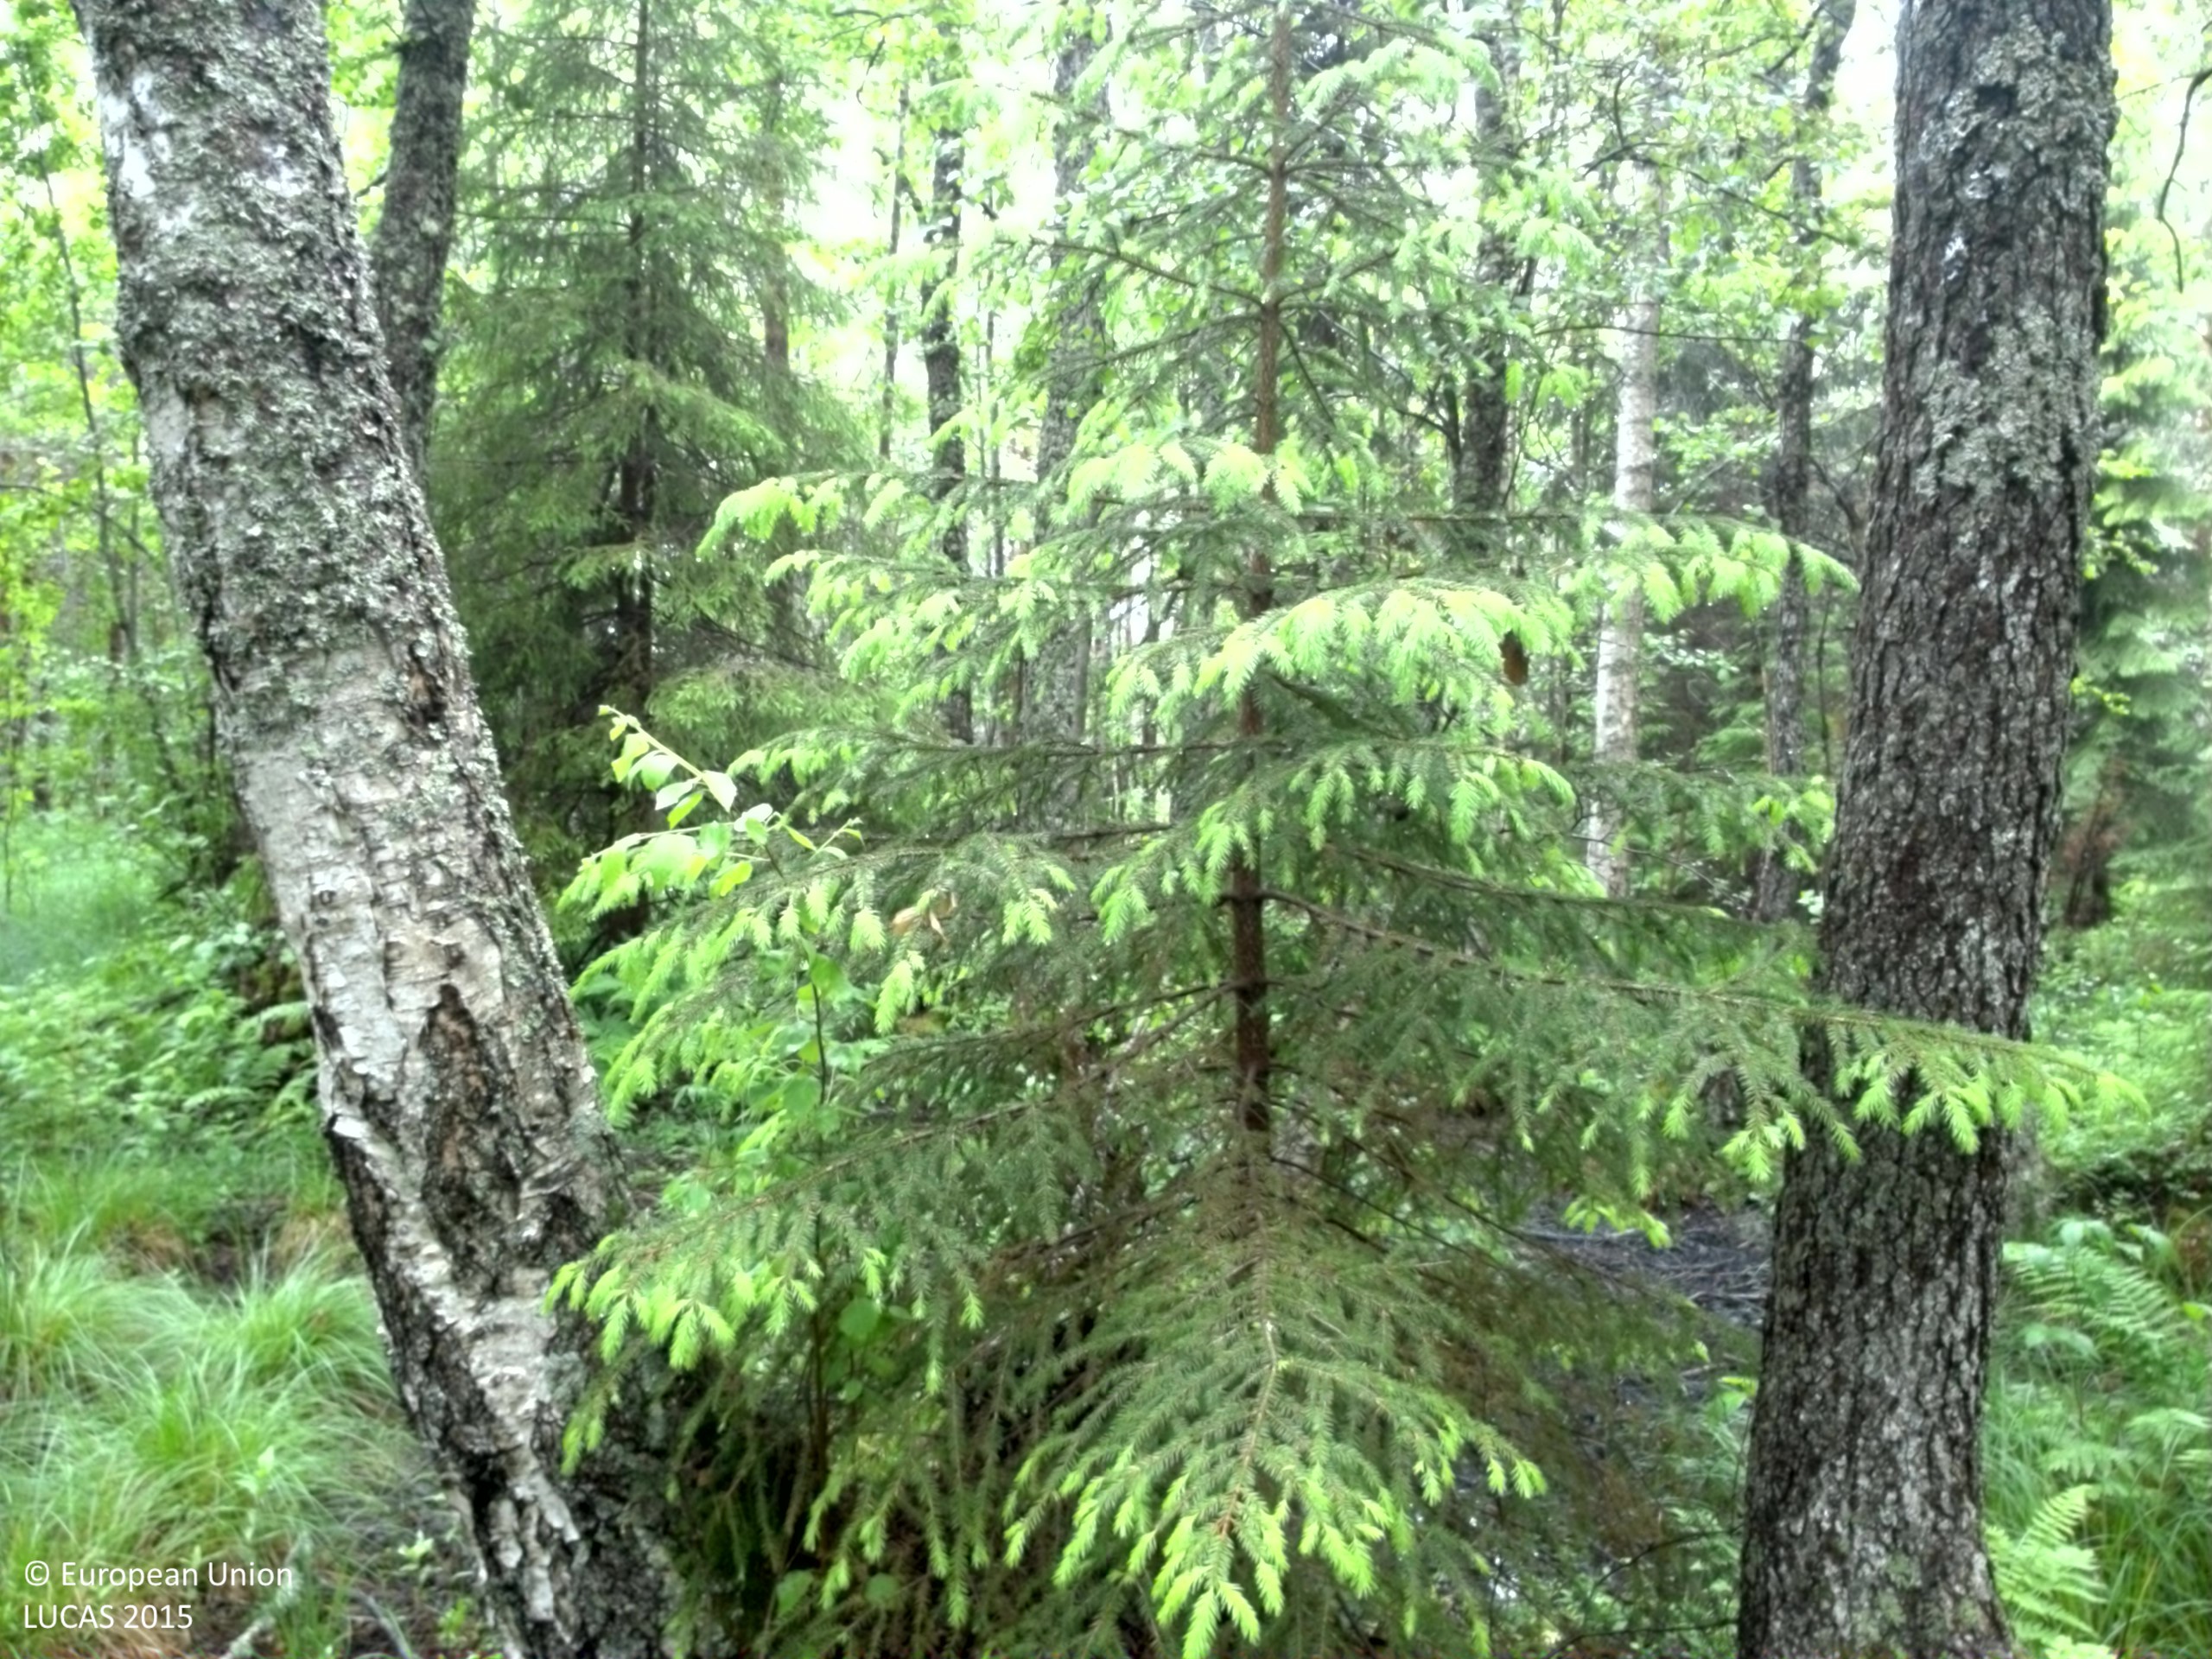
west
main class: Woodland
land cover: Broadleaved woodland
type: boreal forest
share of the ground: 50 - 75 %
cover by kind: broadleaved forest trees 50 %, herbaceous plants 25 %, coniferous forest trees 15 %, shrubs 5 %, lichens and mosses 5 %
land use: Forestry
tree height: > 5 m
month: June
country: SE
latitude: 60.4000
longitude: 18.1066
